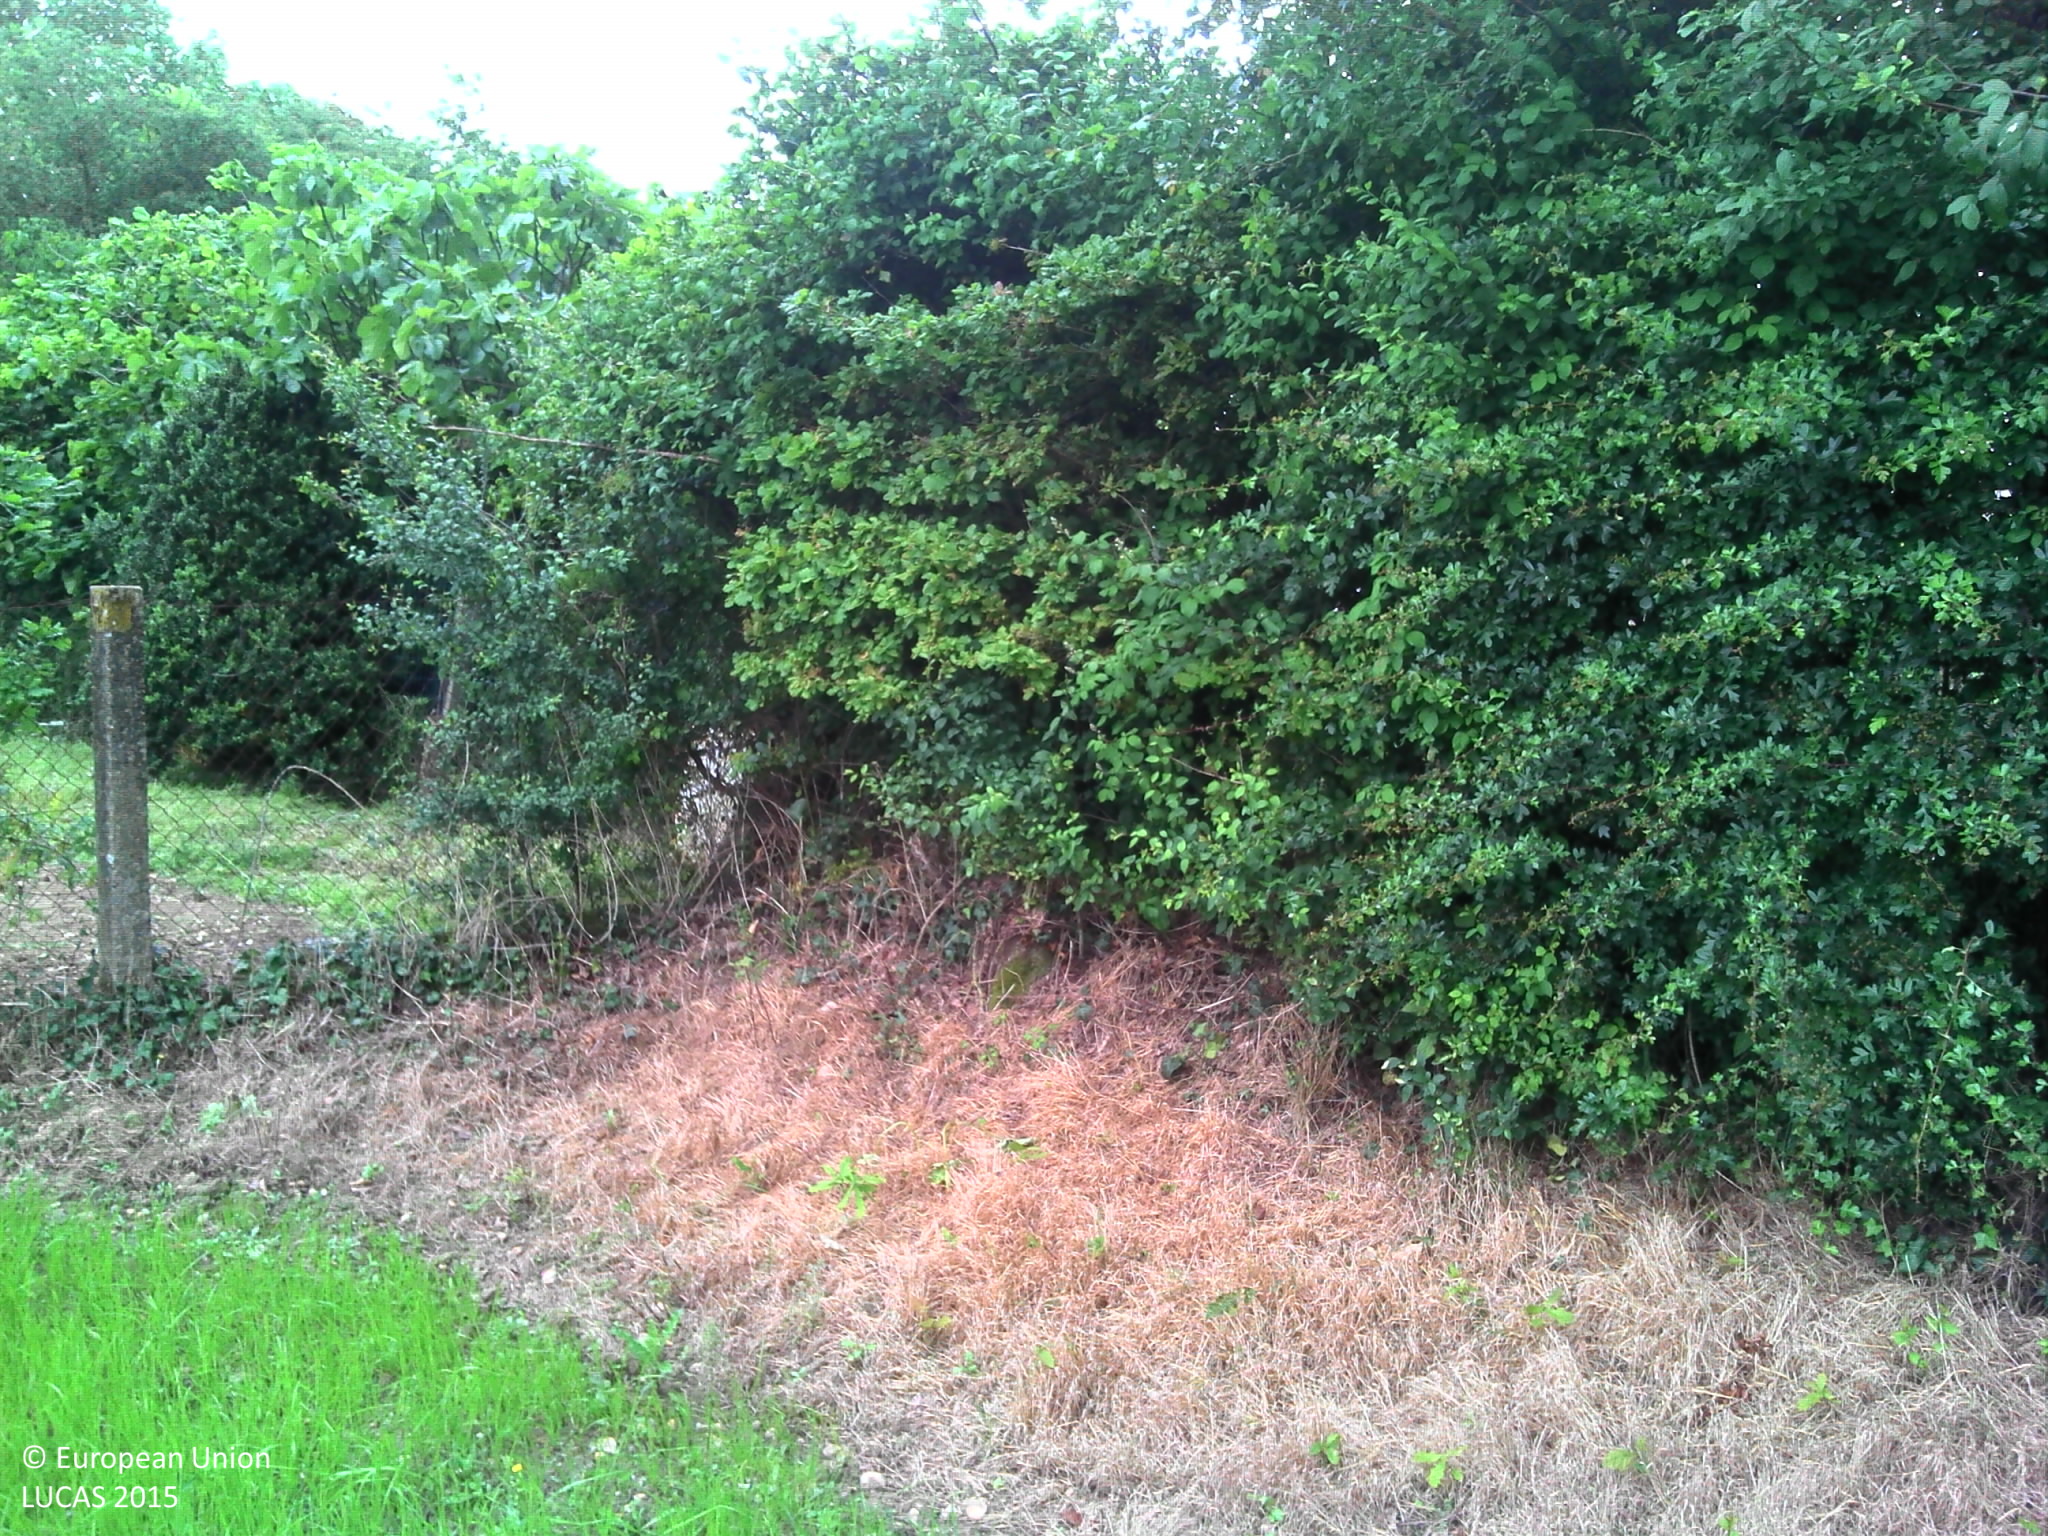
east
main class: Grassland
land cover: Grassland without tree/shrub cover
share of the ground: > 75 %
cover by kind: herbaceous plants 100 %
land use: Residential
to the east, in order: Grassland without tree/shrub cover; Artificial constructions in urban areas; Ditches and canals; Grass margins; Paved roads, cycling and walking lanes; Grass margins; Ditches and canals; Artificial constructions in urban areas; Lines of trees; Grassland without tree/shrub cover
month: June
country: FR
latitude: 46.8588
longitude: -1.8093
